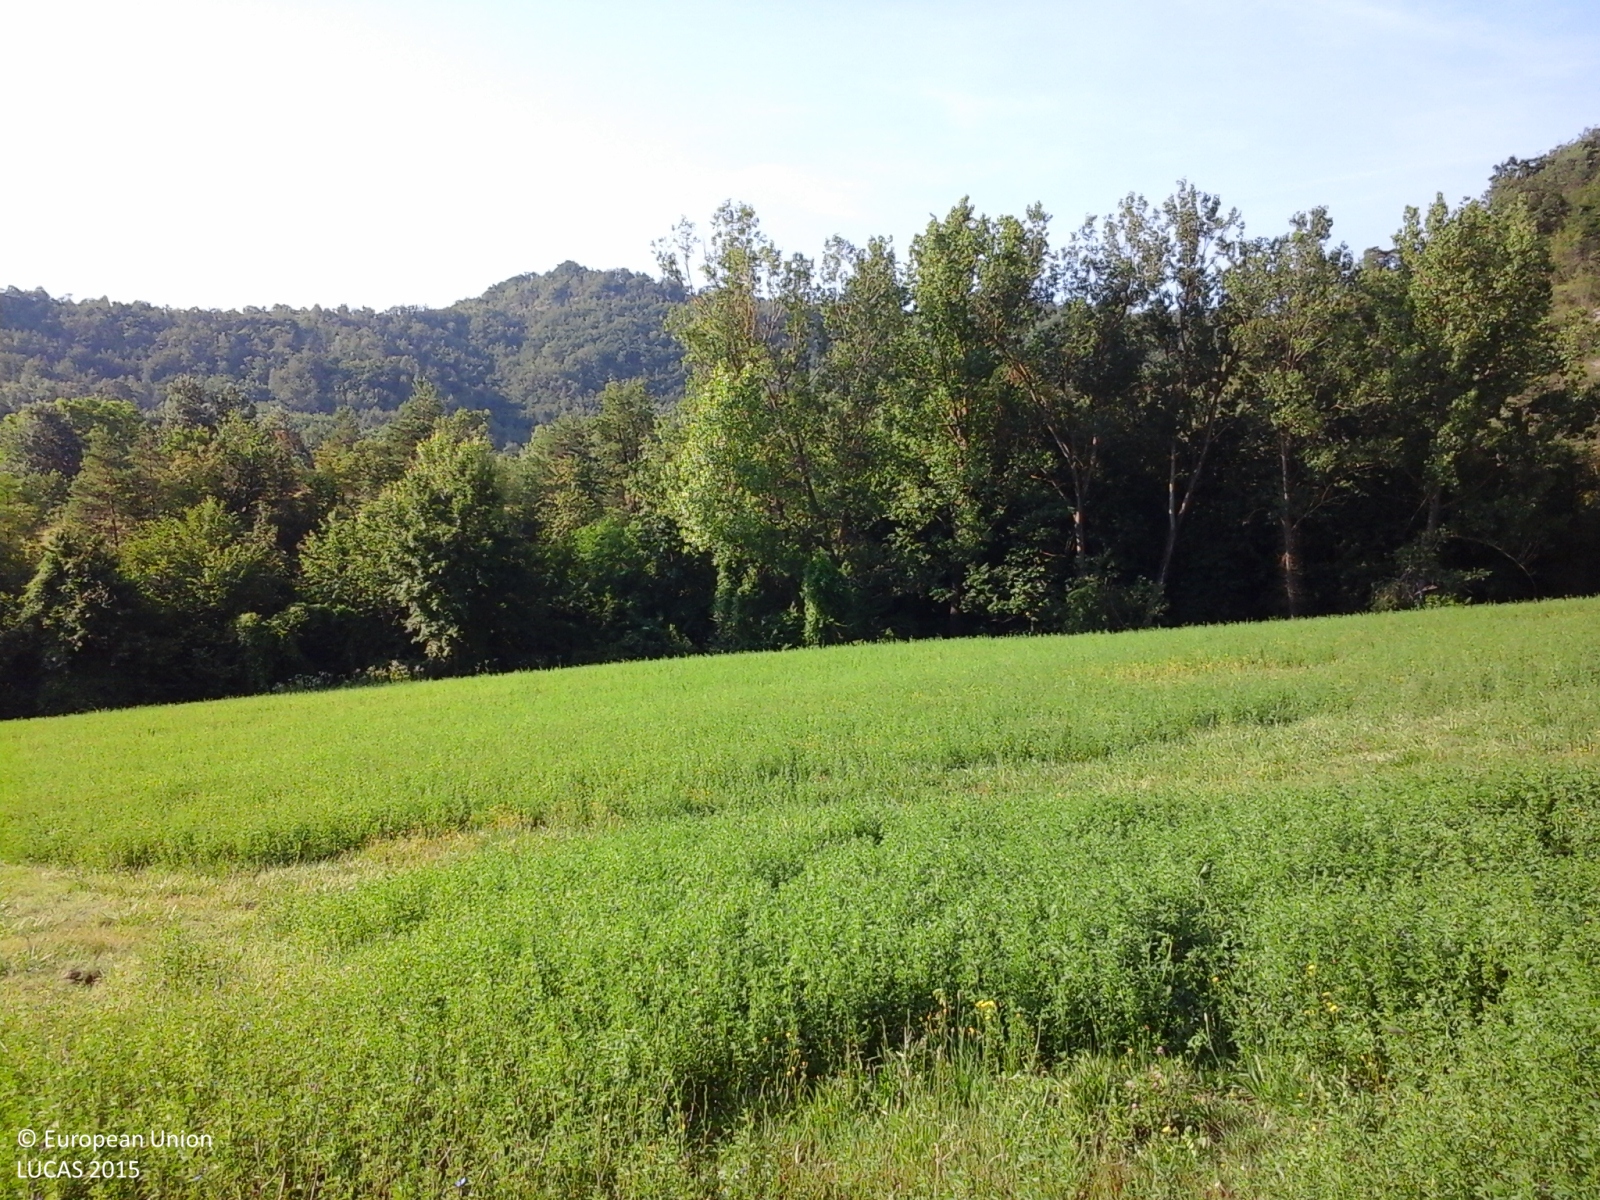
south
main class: Cropland
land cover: Lucerne
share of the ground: > 75 %
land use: Agriculture (excluding fallow land and kitchen gardens)
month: June
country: IT
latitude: 44.5167
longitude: 8.2801
